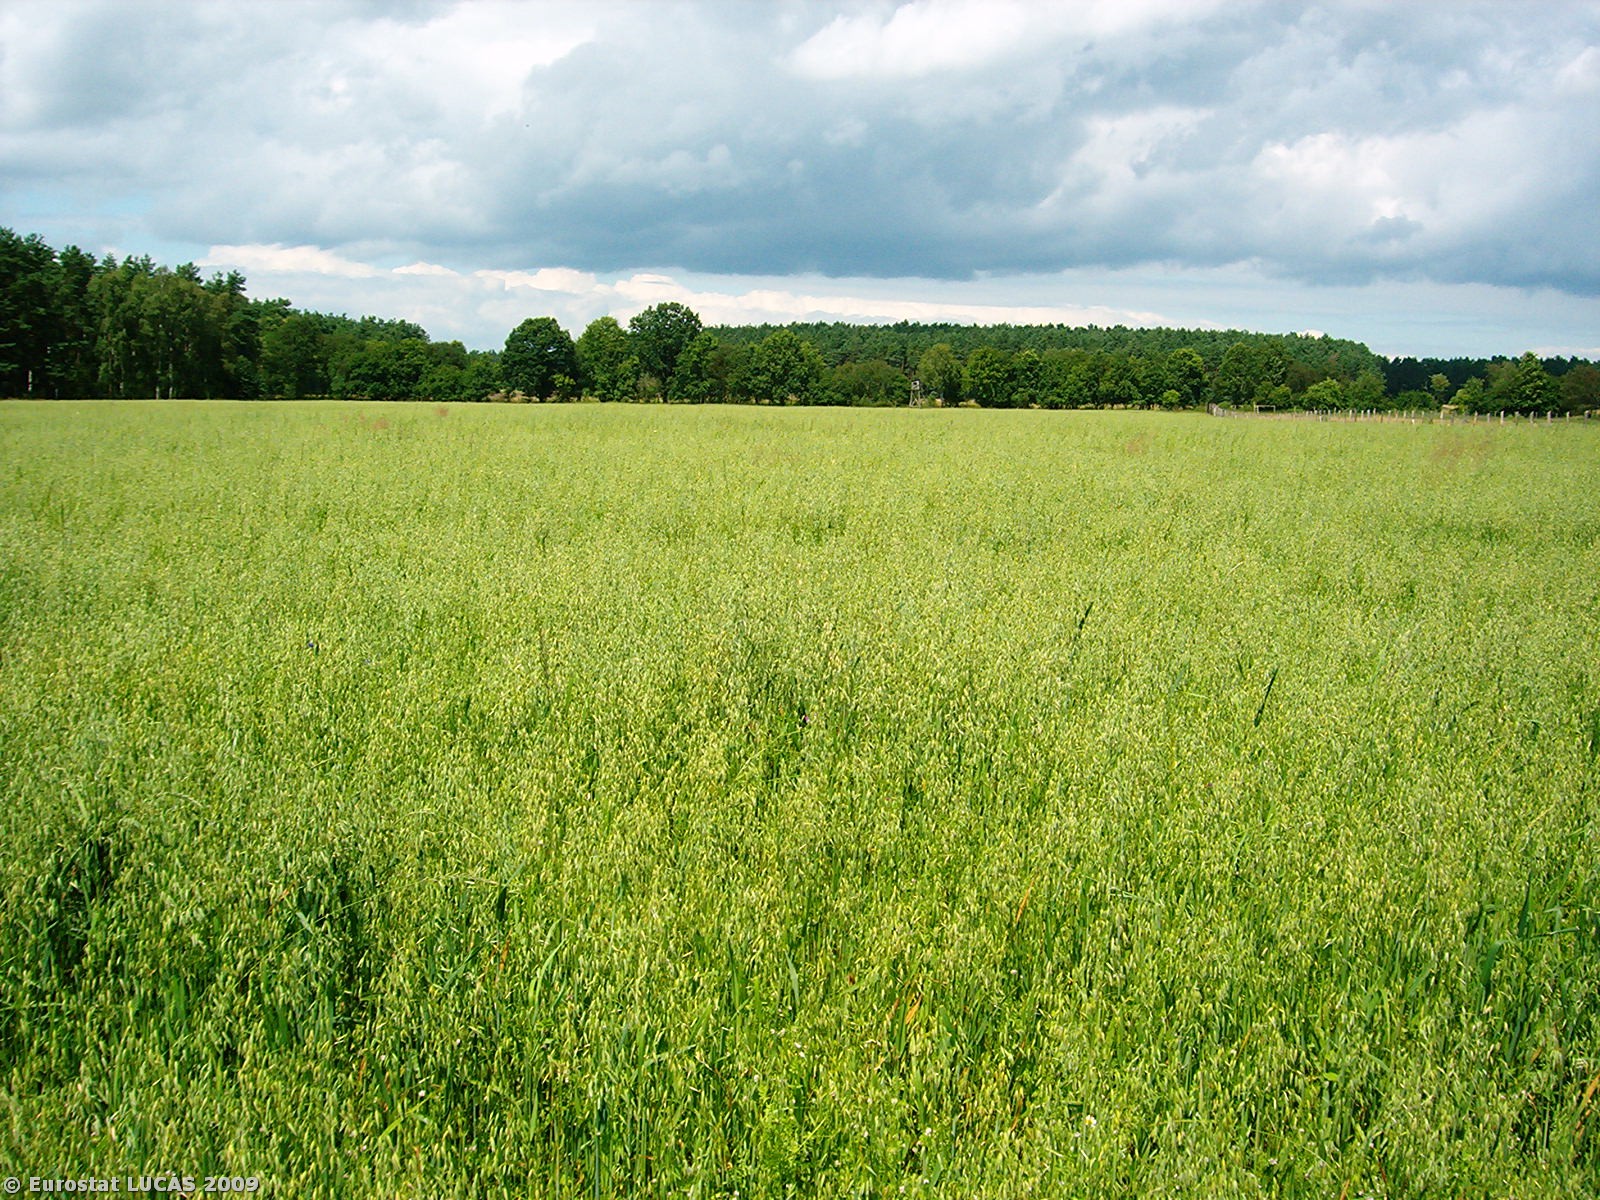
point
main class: Cropland
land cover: Oats
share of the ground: > 75 %
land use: Agriculture (excluding fallow land and kitchen gardens)
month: July
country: PL
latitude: 52.2569
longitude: 15.3508
